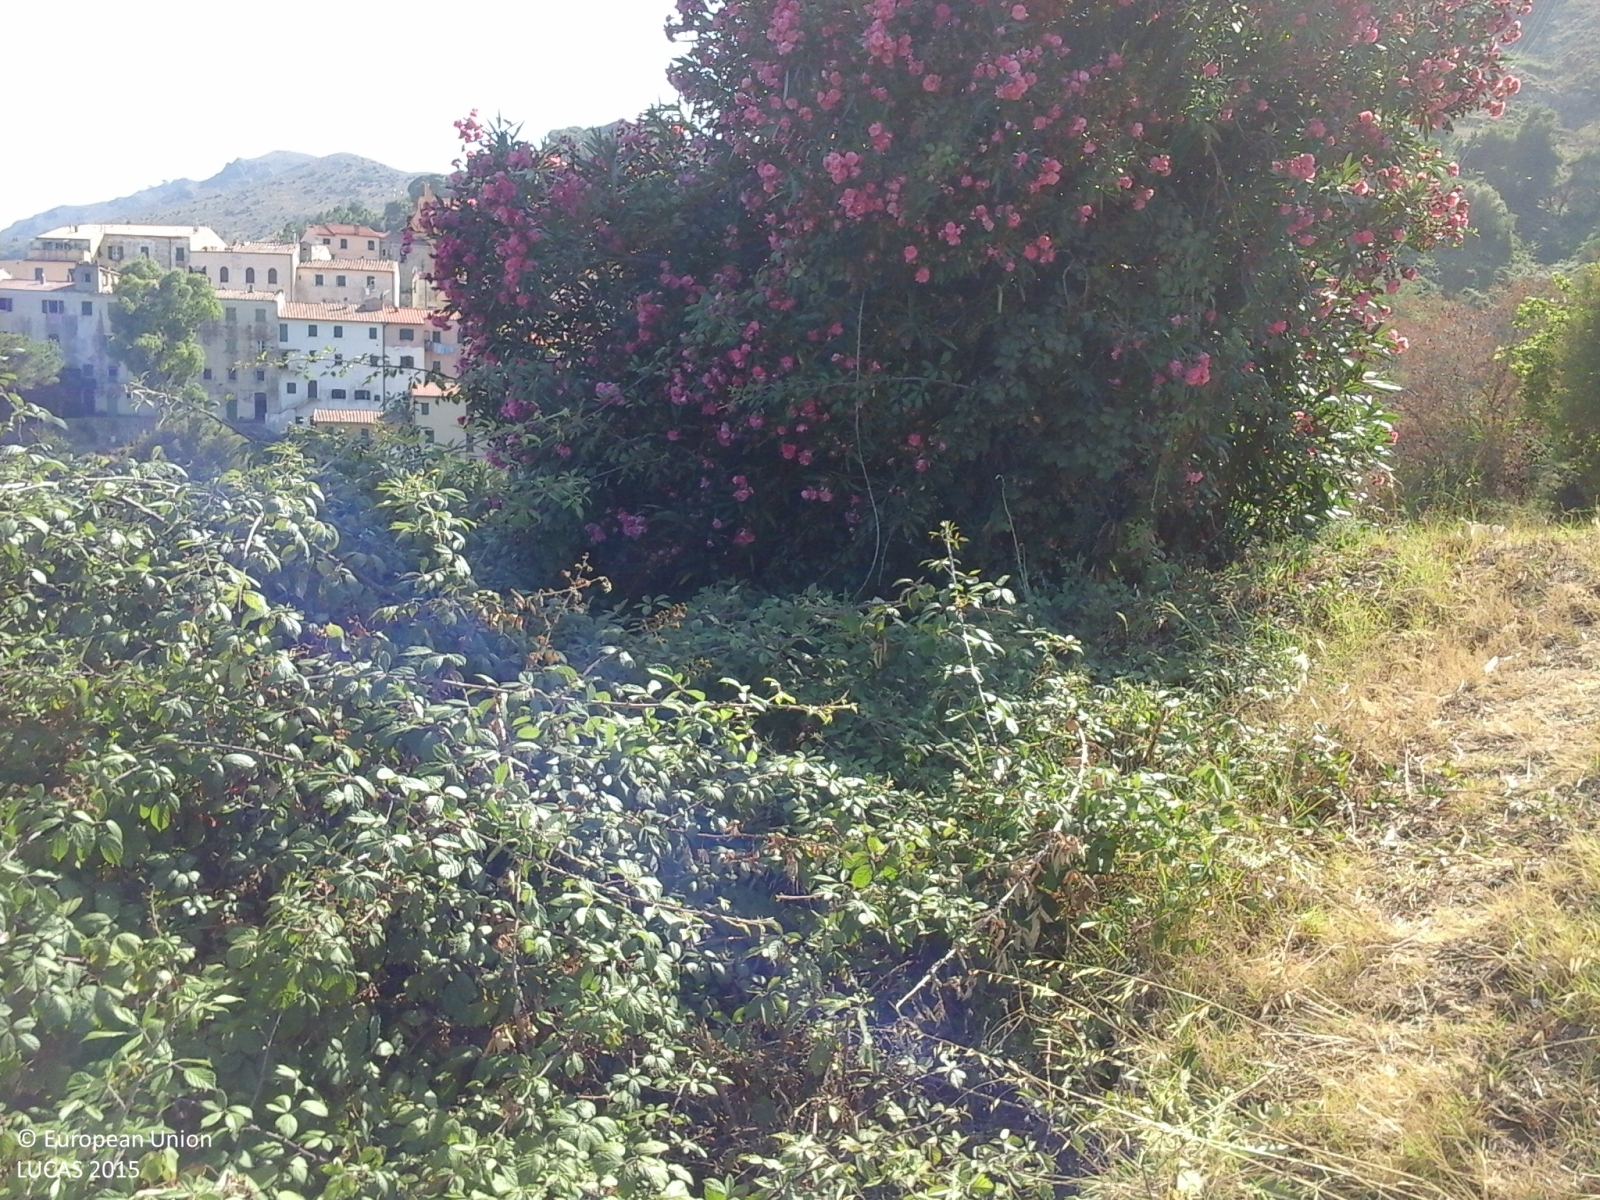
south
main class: Woodland
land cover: Broadleaved woodland
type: broadleaved evergreen forest
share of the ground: > 75 %
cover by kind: broadleaved forest trees 55 %, herbaceous plants 35 %, shrubs 10 %
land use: Semi-natural and natural areas not in use
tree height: < 5 m
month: July
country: IT
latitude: 42.8158
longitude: 10.4023
